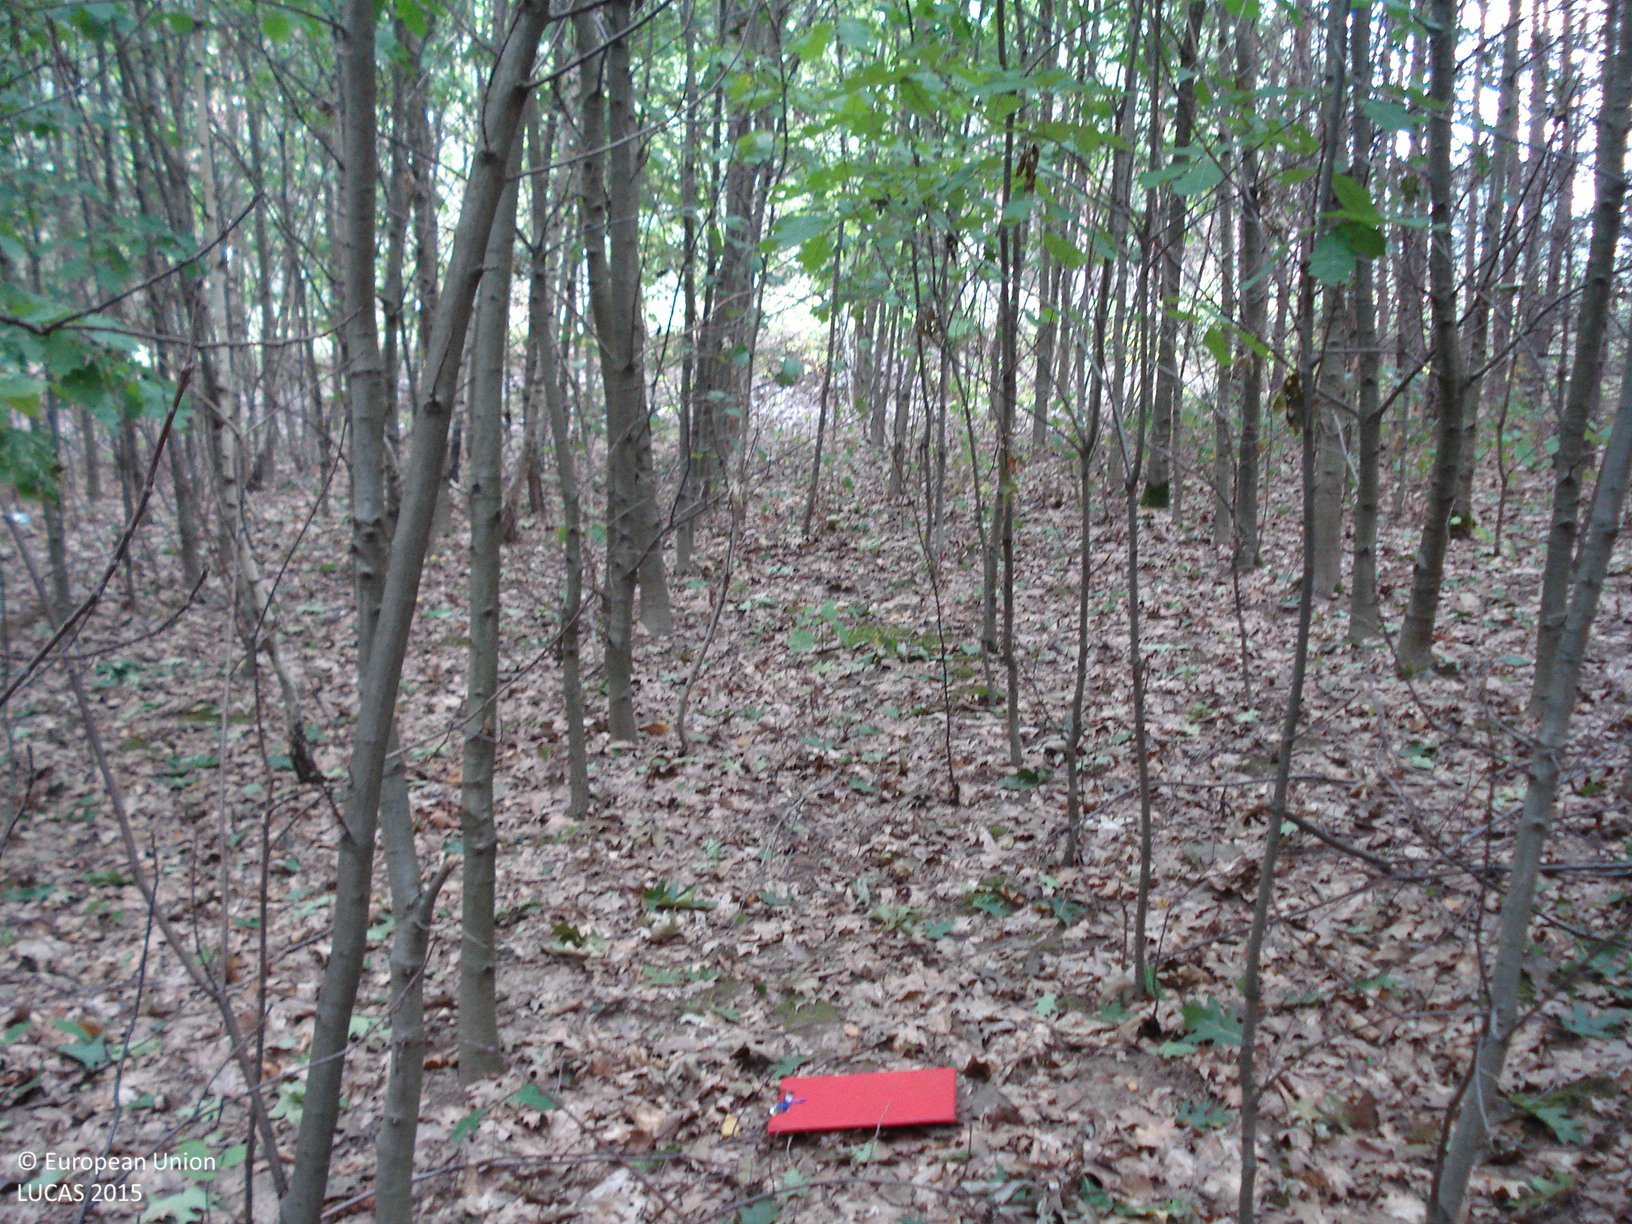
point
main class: Woodland
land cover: Broadleaved woodland
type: mesophytic deciduous forest
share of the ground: > 75 %
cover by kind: broadleaved forest trees 80 %, unconsolidated bare surface 15 %, herbaceous plants 5 %
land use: Forestry
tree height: < 5 m
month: September
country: PL
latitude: 50.8389
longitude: 20.9065
